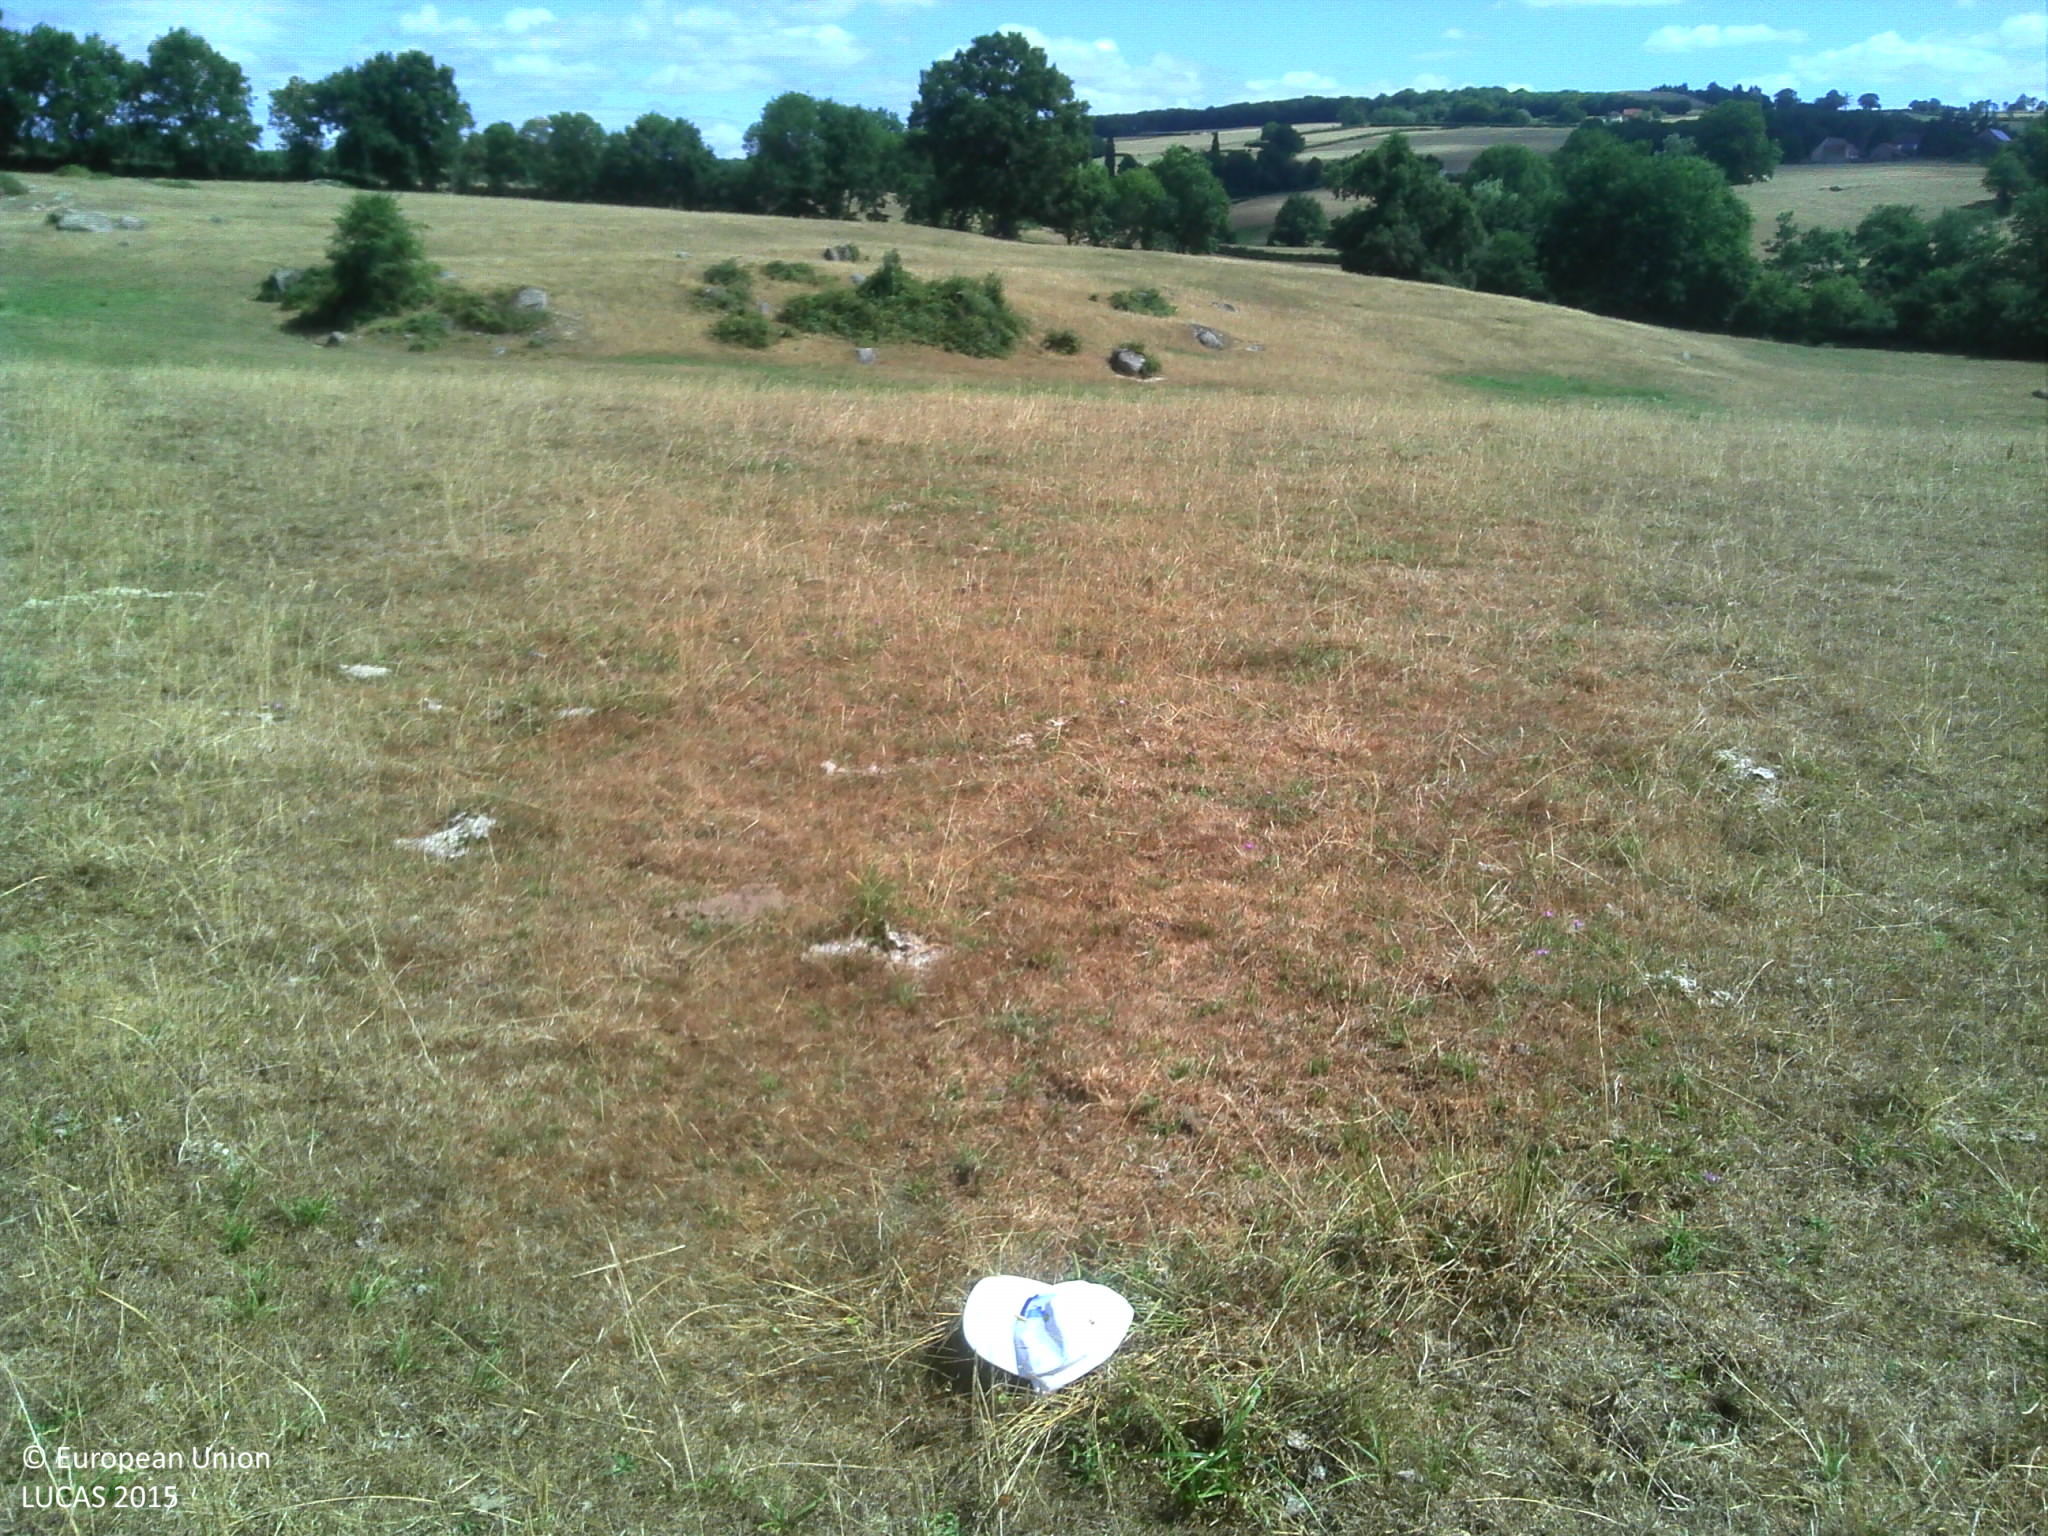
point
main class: Grassland
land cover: Grassland without tree/shrub cover
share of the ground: > 75 %
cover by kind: herbaceous plants 100 %
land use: Agriculture (excluding fallow land and kitchen gardens)
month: July
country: FR
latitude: 46.8418
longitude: 4.5064
